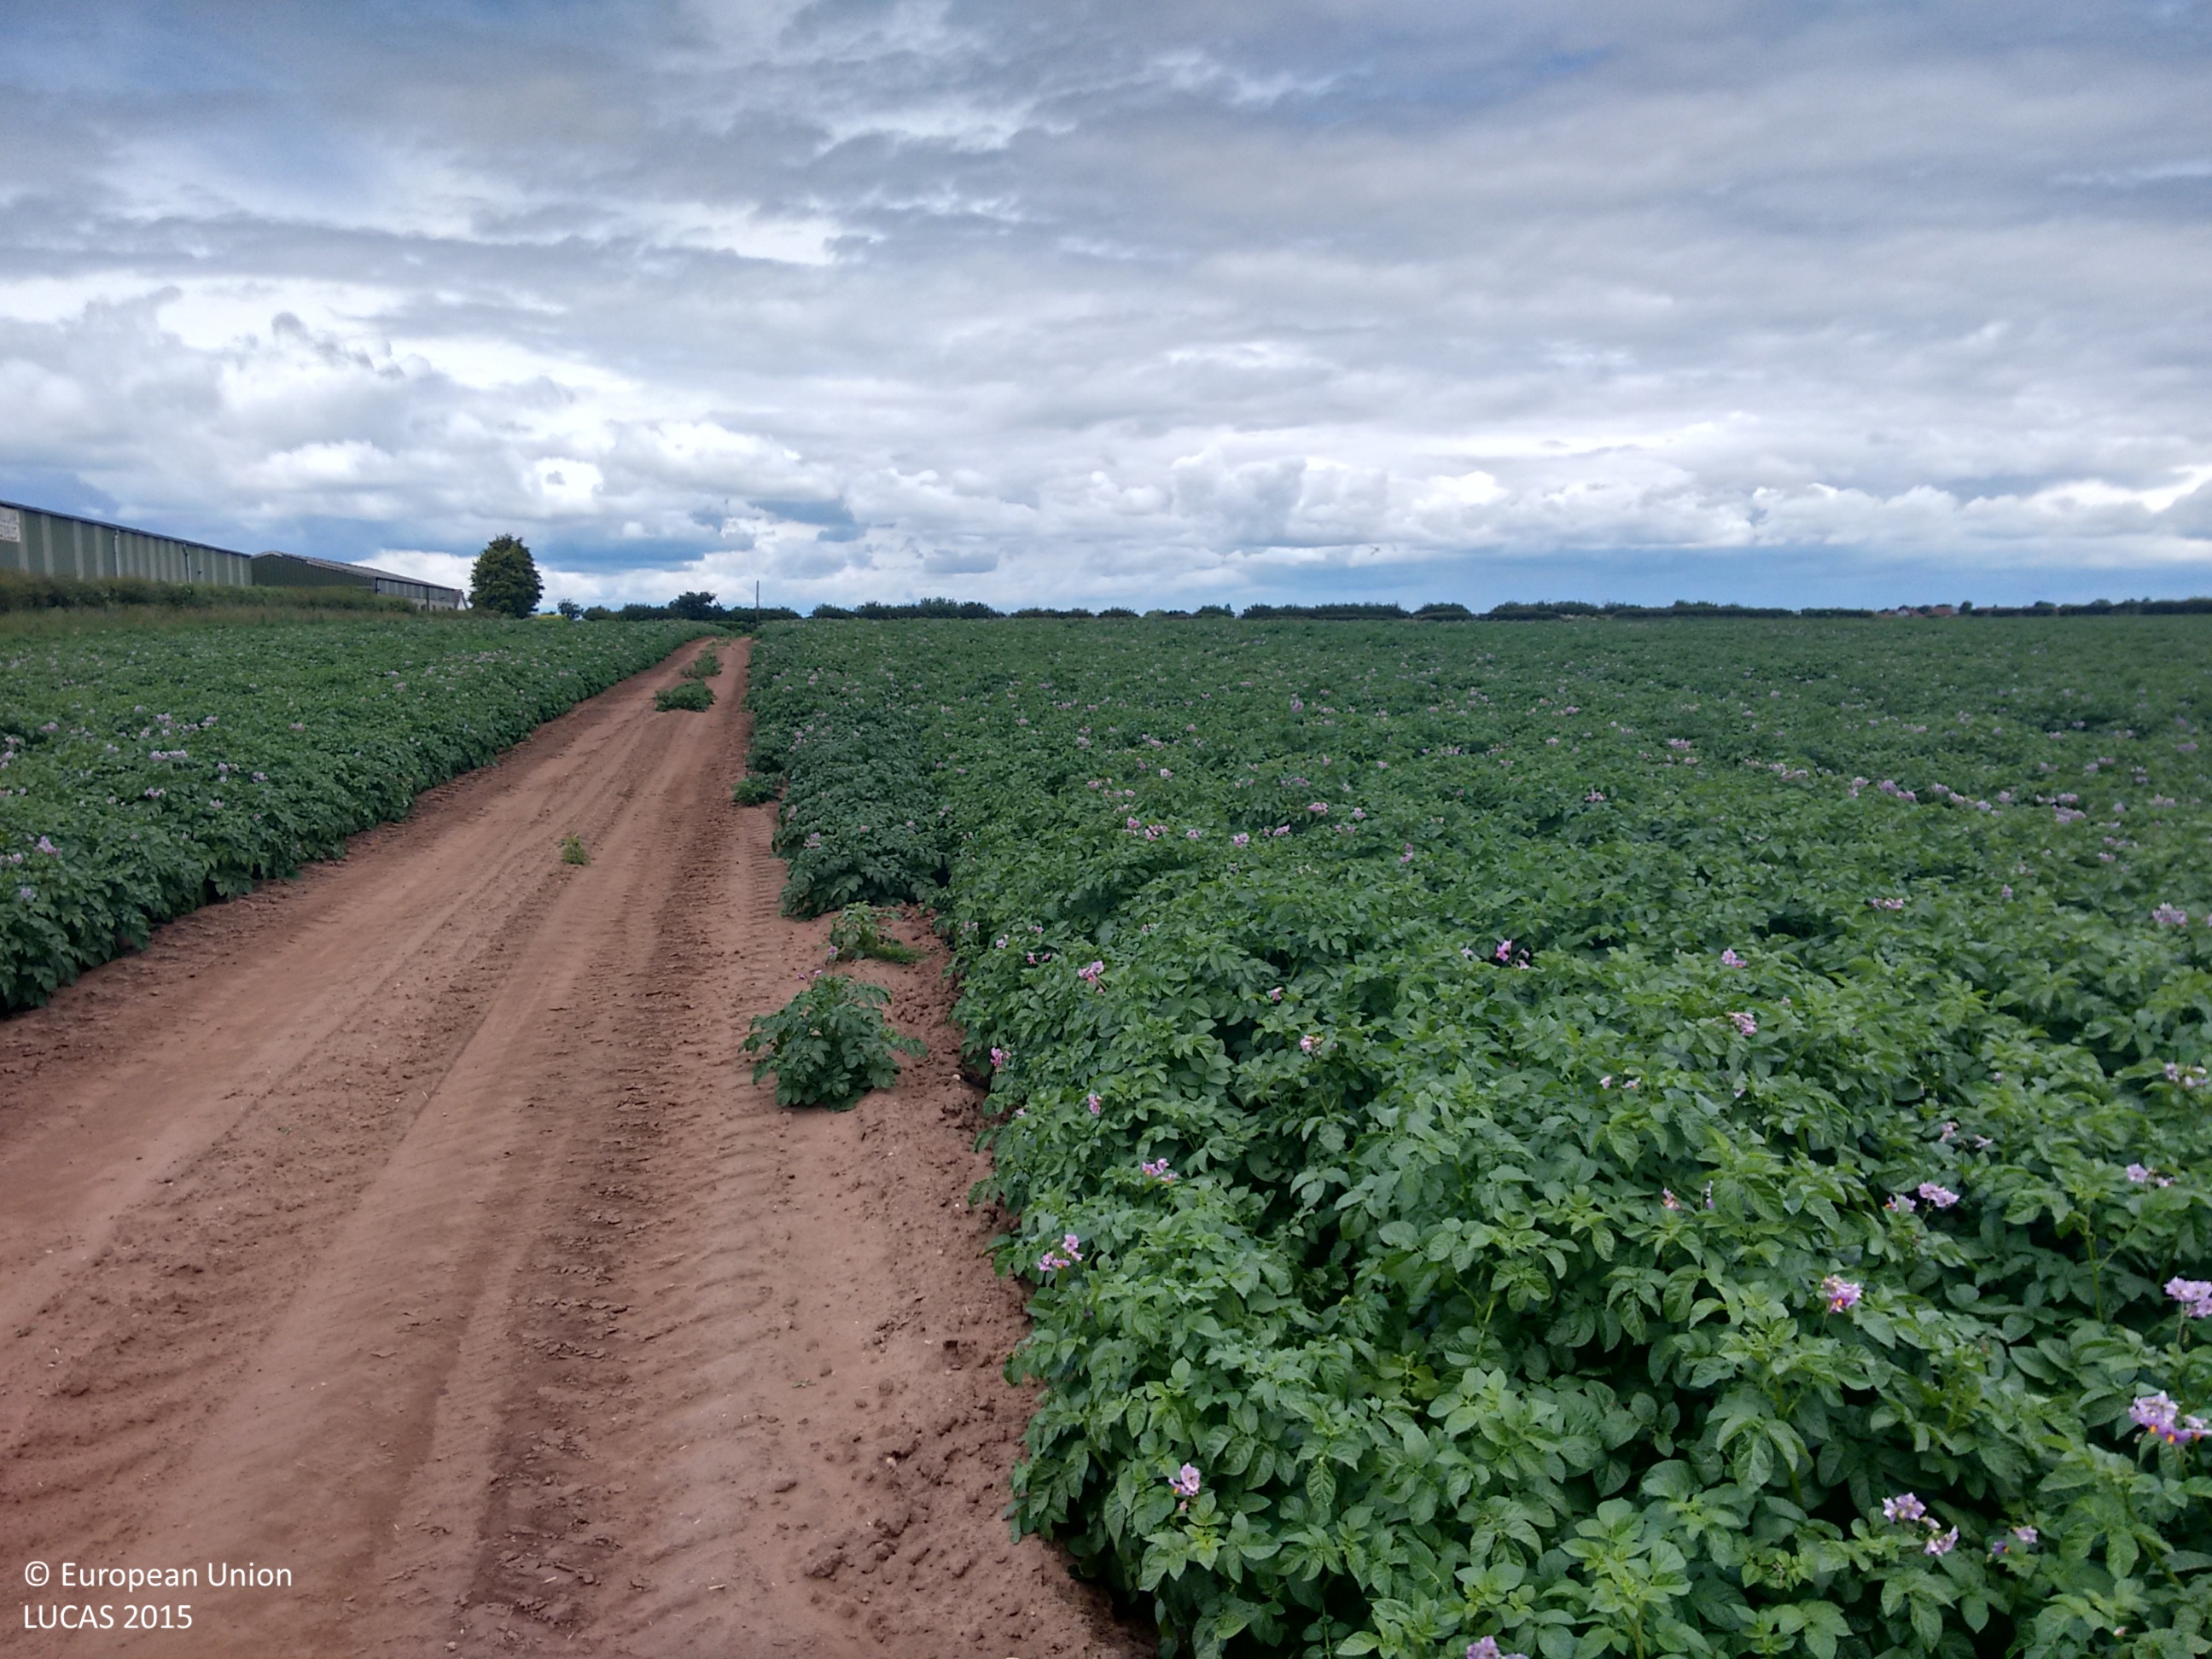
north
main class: Cropland
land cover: Potatoes
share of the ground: > 75 %
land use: Agriculture (excluding fallow land and kitchen gardens)
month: June
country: GB
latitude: 53.7611
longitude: -1.1024
